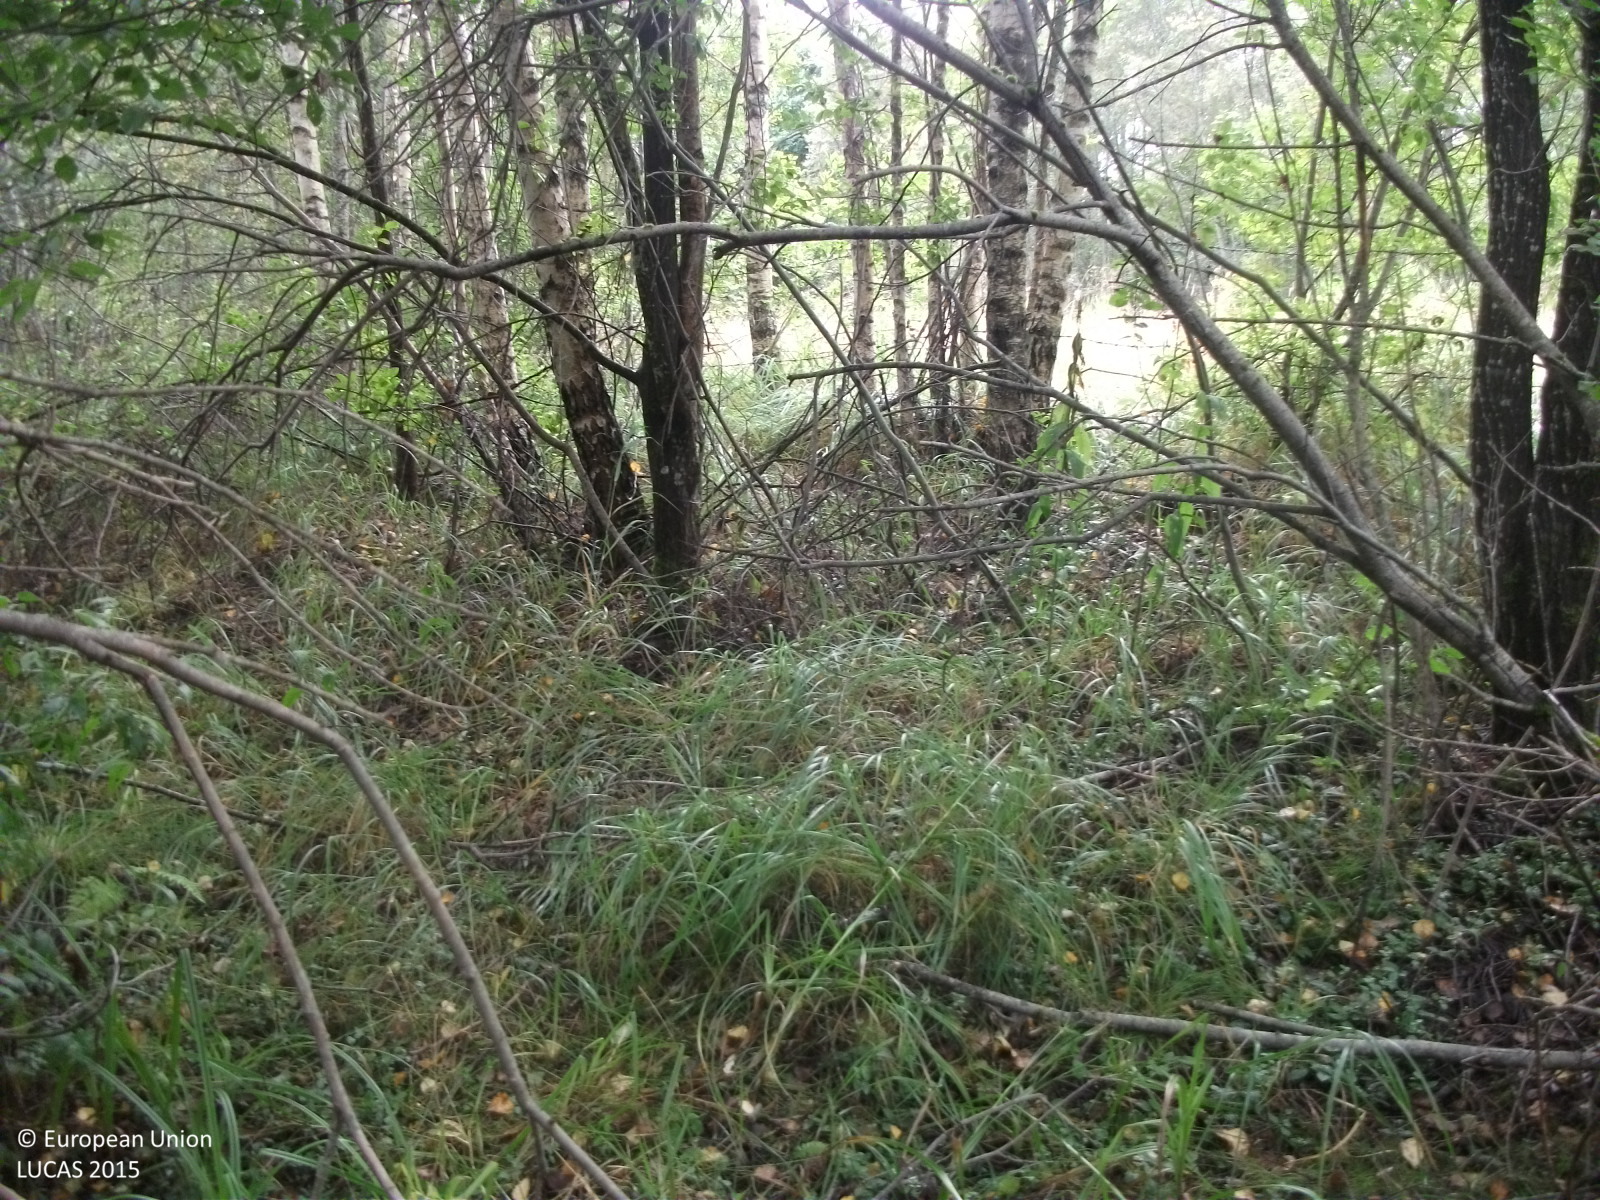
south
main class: Woodland
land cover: Broadleaved woodland
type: non-riverine alder, birch or aspen forest
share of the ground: 50 - 75 %
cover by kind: broadleaved forest trees 60 %, shrubs 25 %, herbaceous plants 15 %
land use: Forestry
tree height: > 5 m
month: September
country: LV
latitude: 57.5735
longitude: 24.8292
